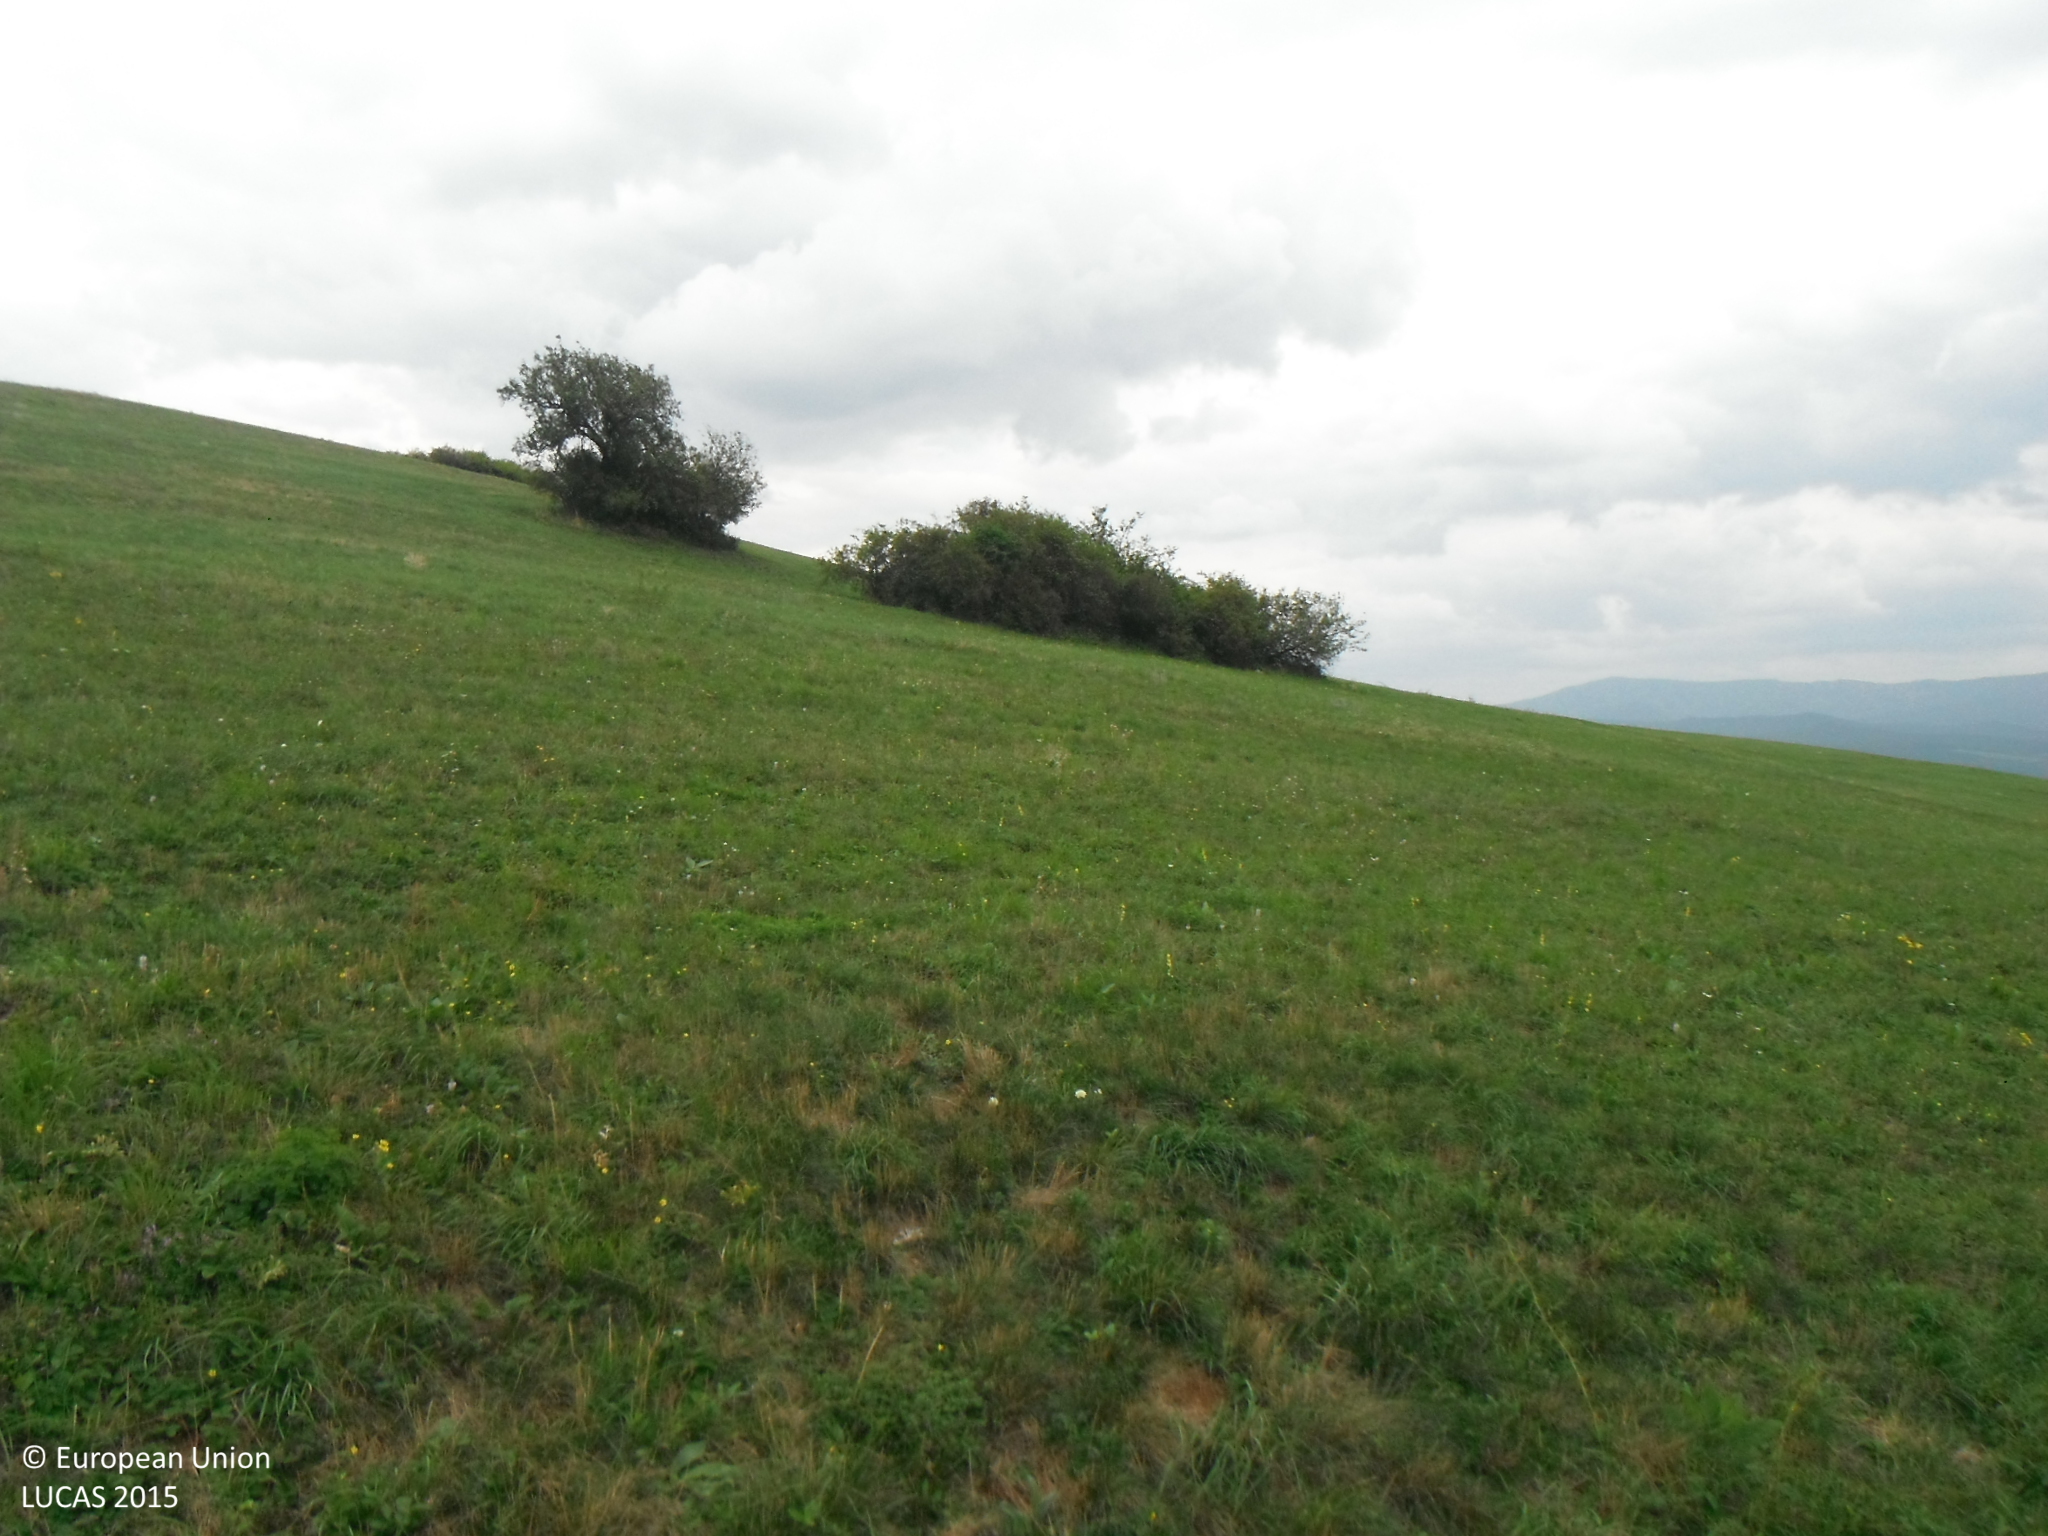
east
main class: Grassland
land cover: Grassland without tree/shrub cover
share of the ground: > 75 %
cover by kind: herbaceous plants 100 %
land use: Agriculture (excluding fallow land and kitchen gardens)
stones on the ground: < 10 %
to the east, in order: Grassland without tree/shrub cover; Single bushes/trees; Grassland without tree/shrub cover; Tracks; Grassland without tree/shrub cover
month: September
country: SK
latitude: 48.8313
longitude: 17.8189
